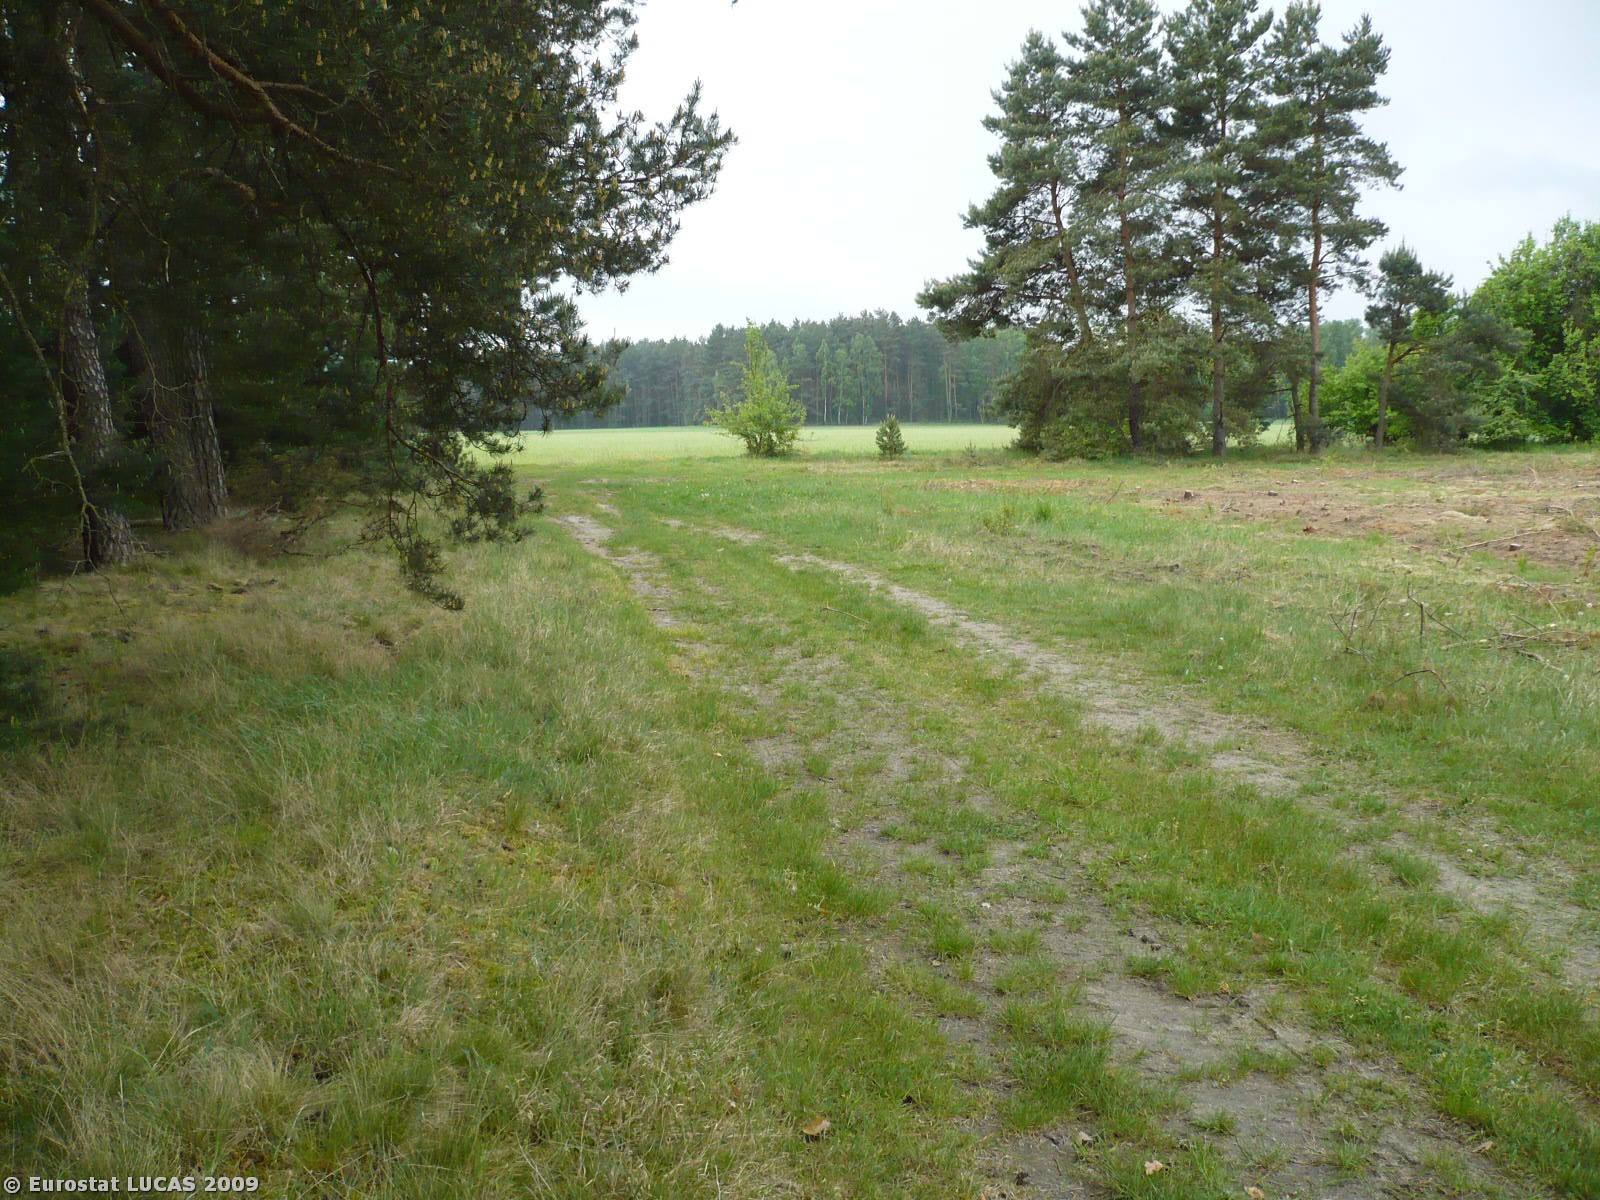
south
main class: Woodland
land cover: Coniferous woodland
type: hemiboreal forest and nemoral coniferous forest and mixed broadleaved-coniferous forest
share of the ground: > 75 %
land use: Forestry
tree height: > 5 m
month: May
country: PL
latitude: 51.9267
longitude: 15.0782
